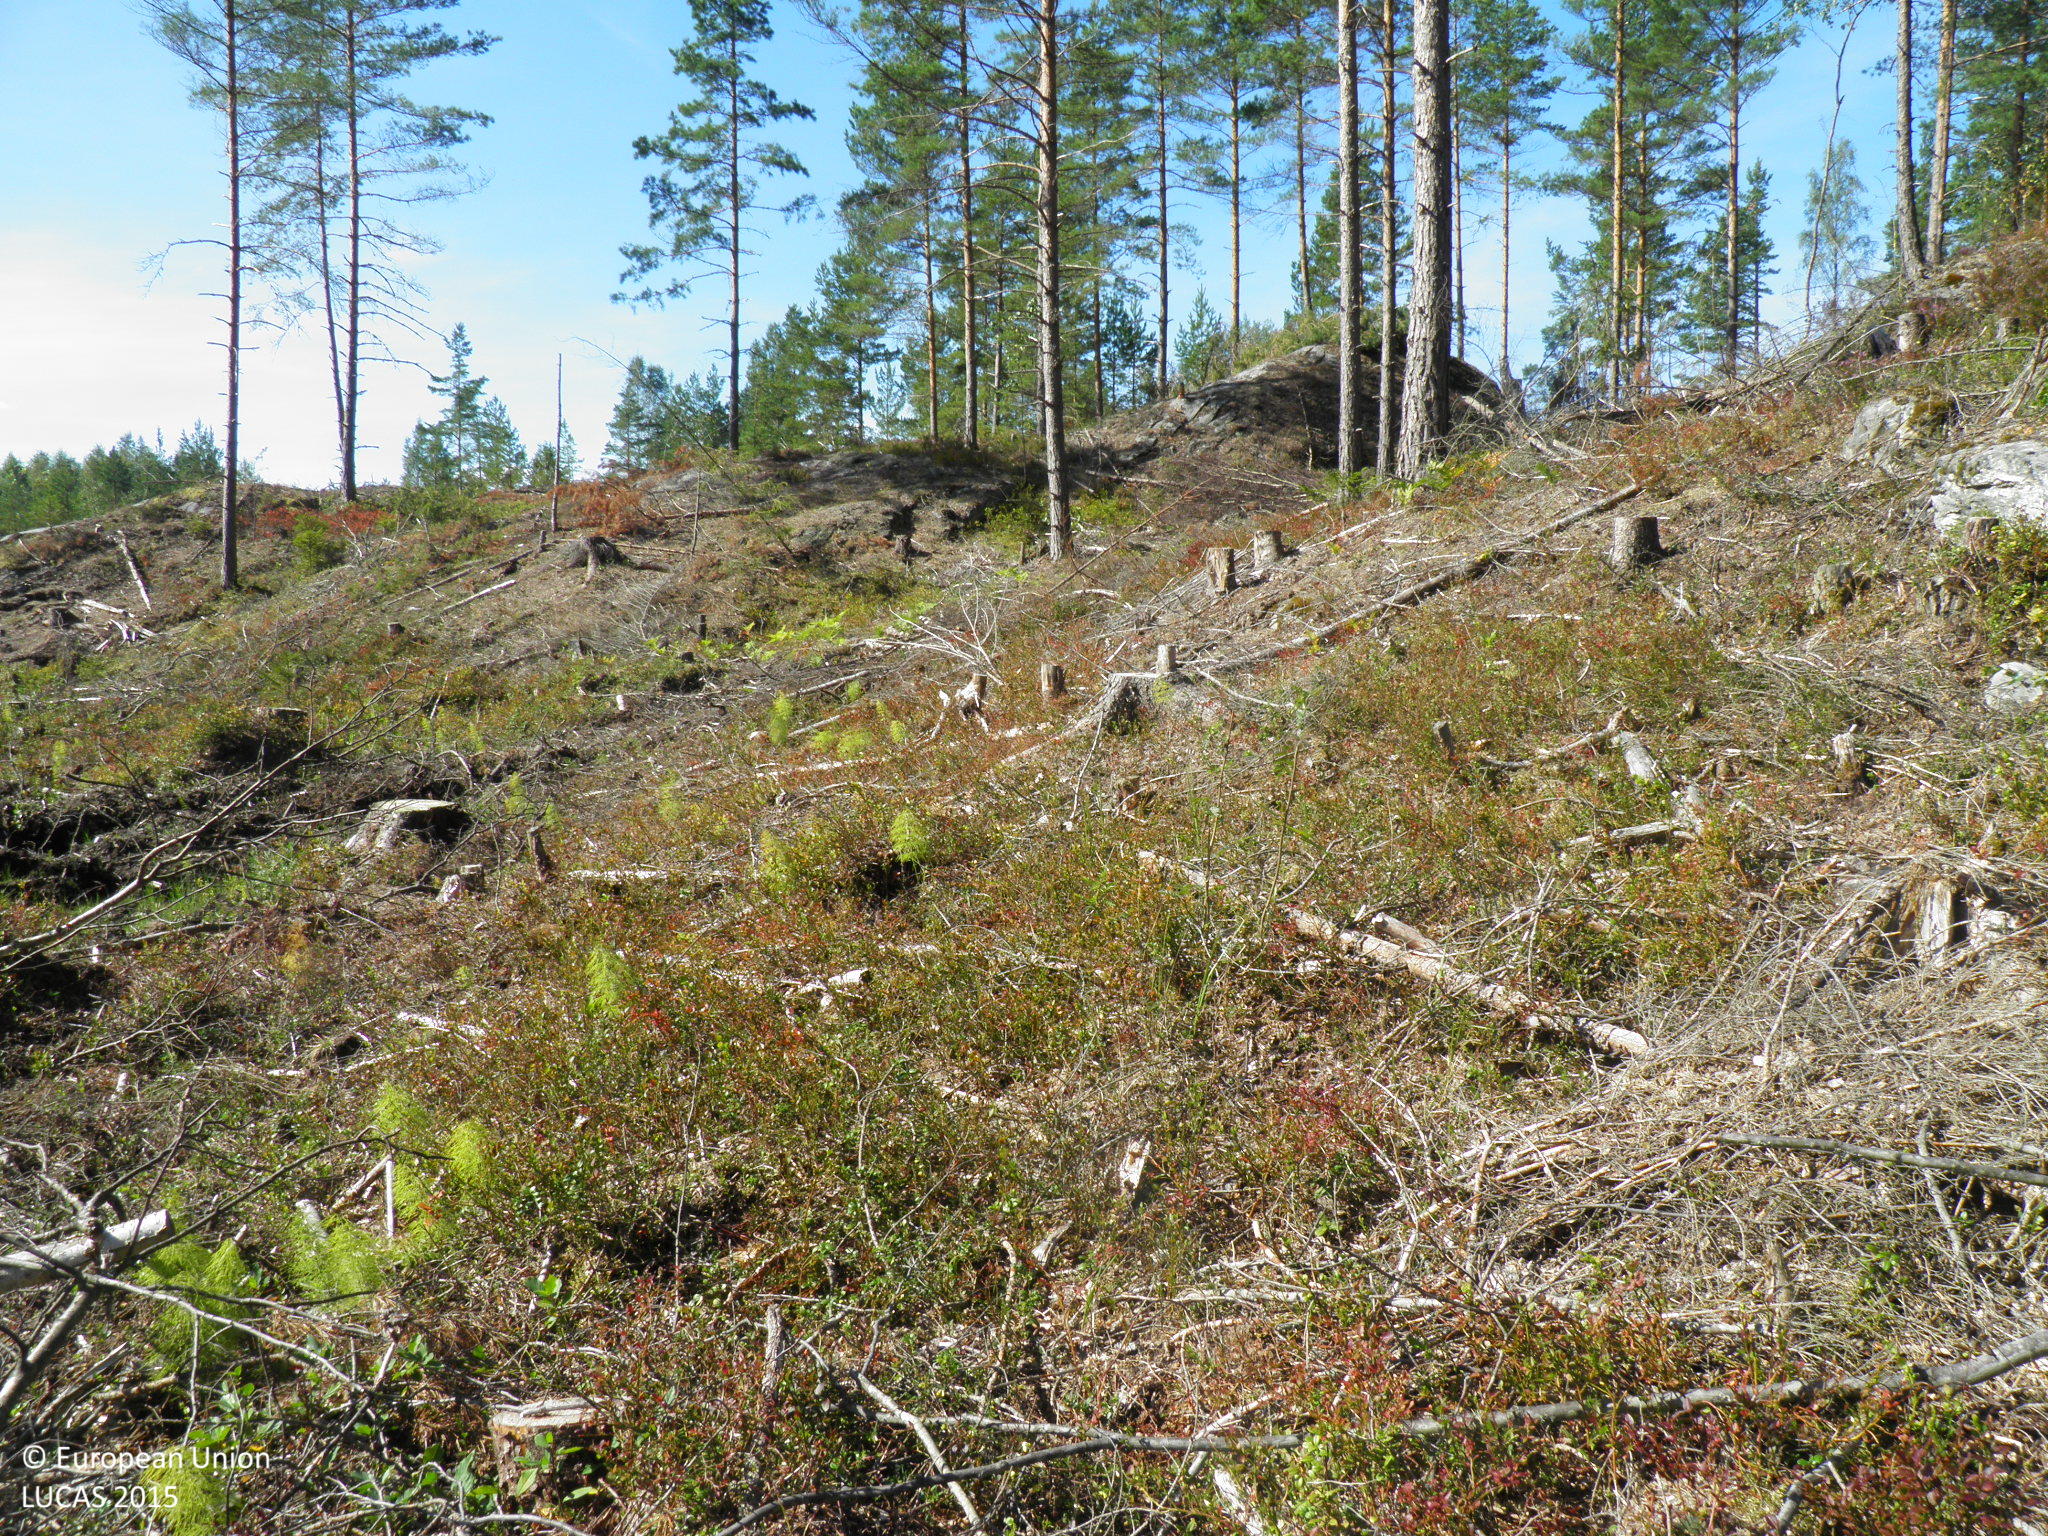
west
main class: Grassland
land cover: Spontaneously vegetated surfaces
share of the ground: 10 - 25 %
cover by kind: unconsolidated bare surface 50 %, consolidated bare surface 15 %, herbaceous plants 10 %, shrubs 5 %
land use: Forestry
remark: Clear cut
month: August
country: FI
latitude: 60.0568
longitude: 22.7392
